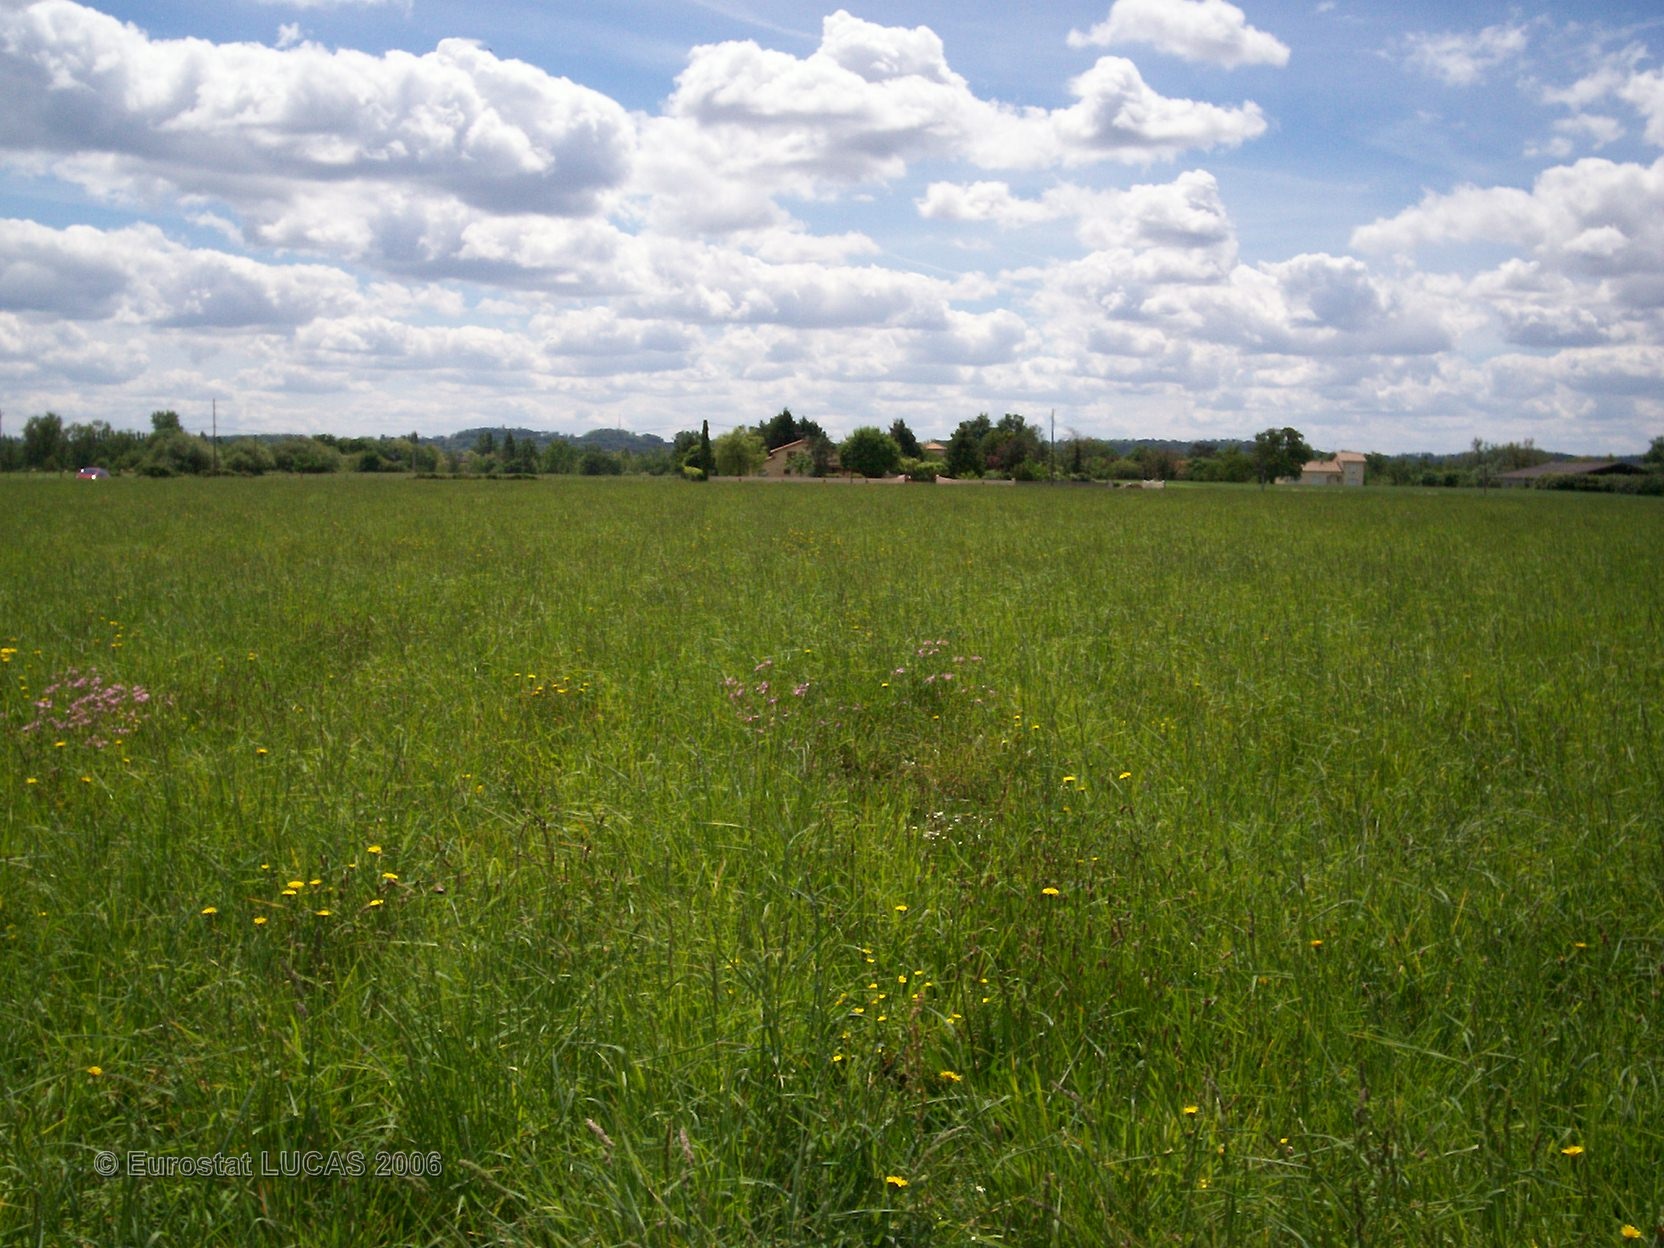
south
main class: Grassland
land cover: Grassland without tree/shrub cover
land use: Agriculture (excluding fallow land and kitchen gardens)
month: May
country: FR
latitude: 45.0282
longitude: -0.0032
